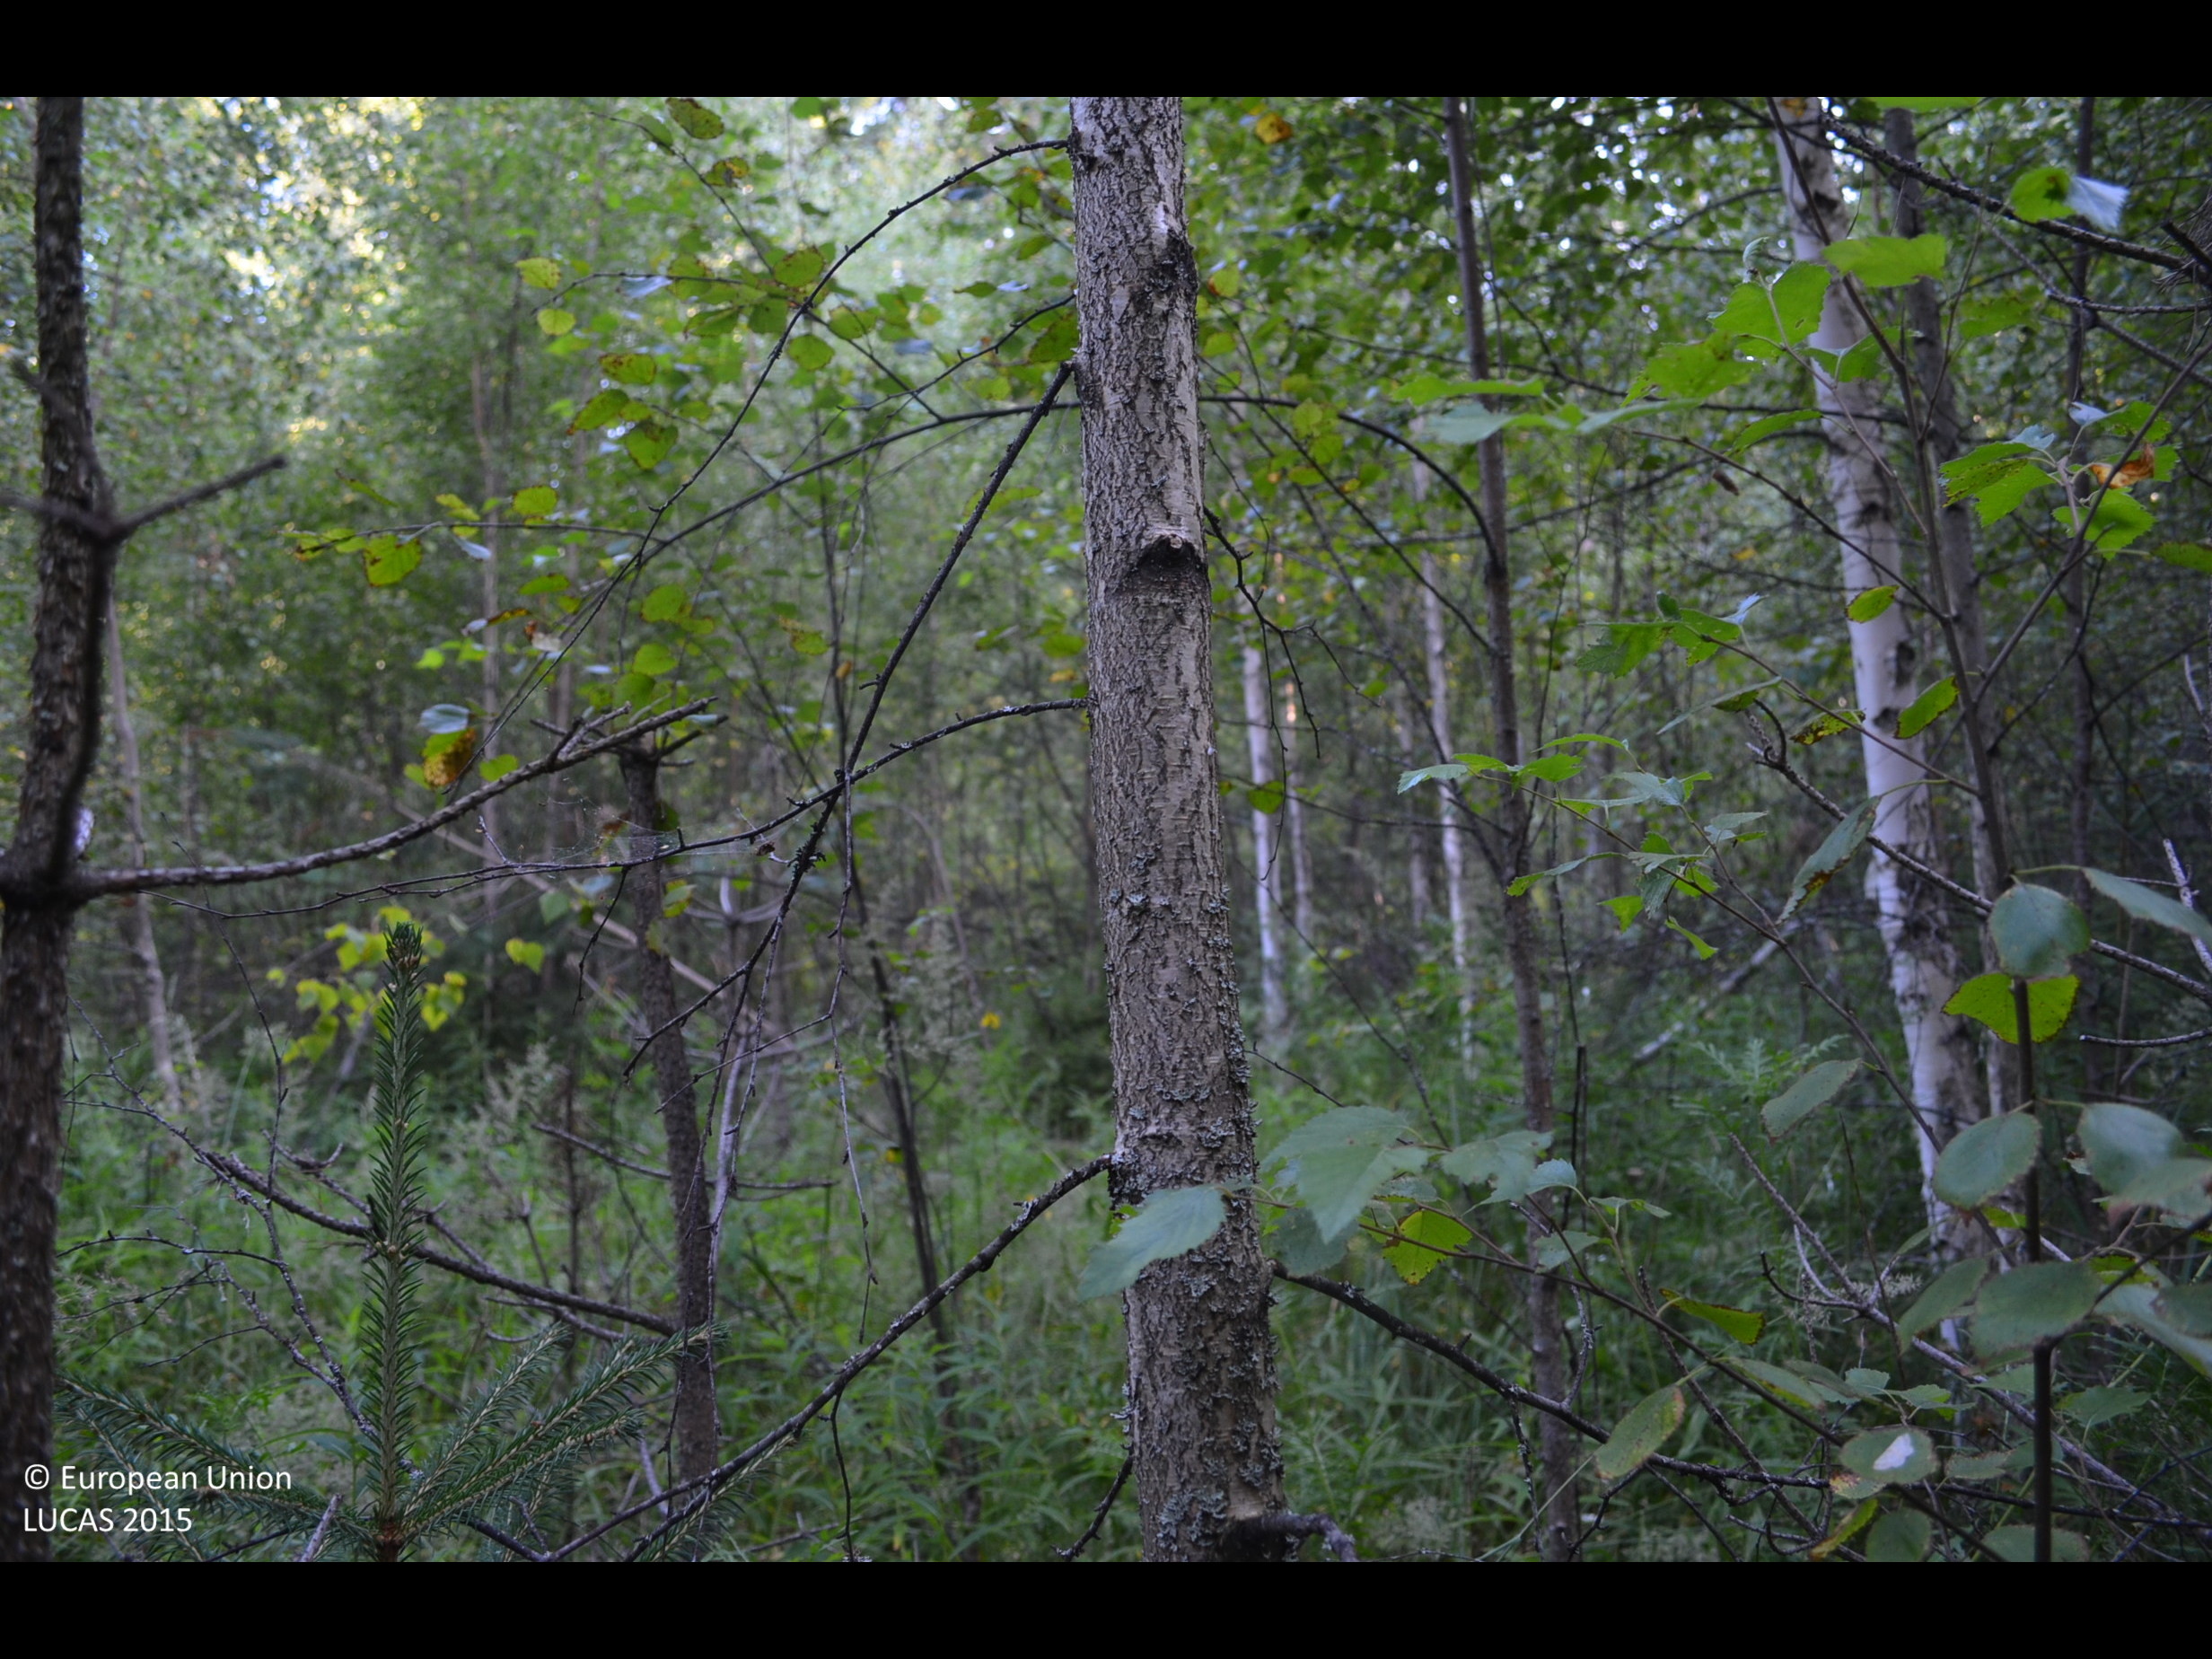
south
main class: Woodland
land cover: Broadleaved woodland
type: boreal forest
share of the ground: > 75 %
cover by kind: broadleaved forest trees 65 %, herbaceous plants 20 %, coniferous forest trees 15 %
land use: Forestry
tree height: > 5 m
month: August
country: FI
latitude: 62.0922
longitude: 24.2804
